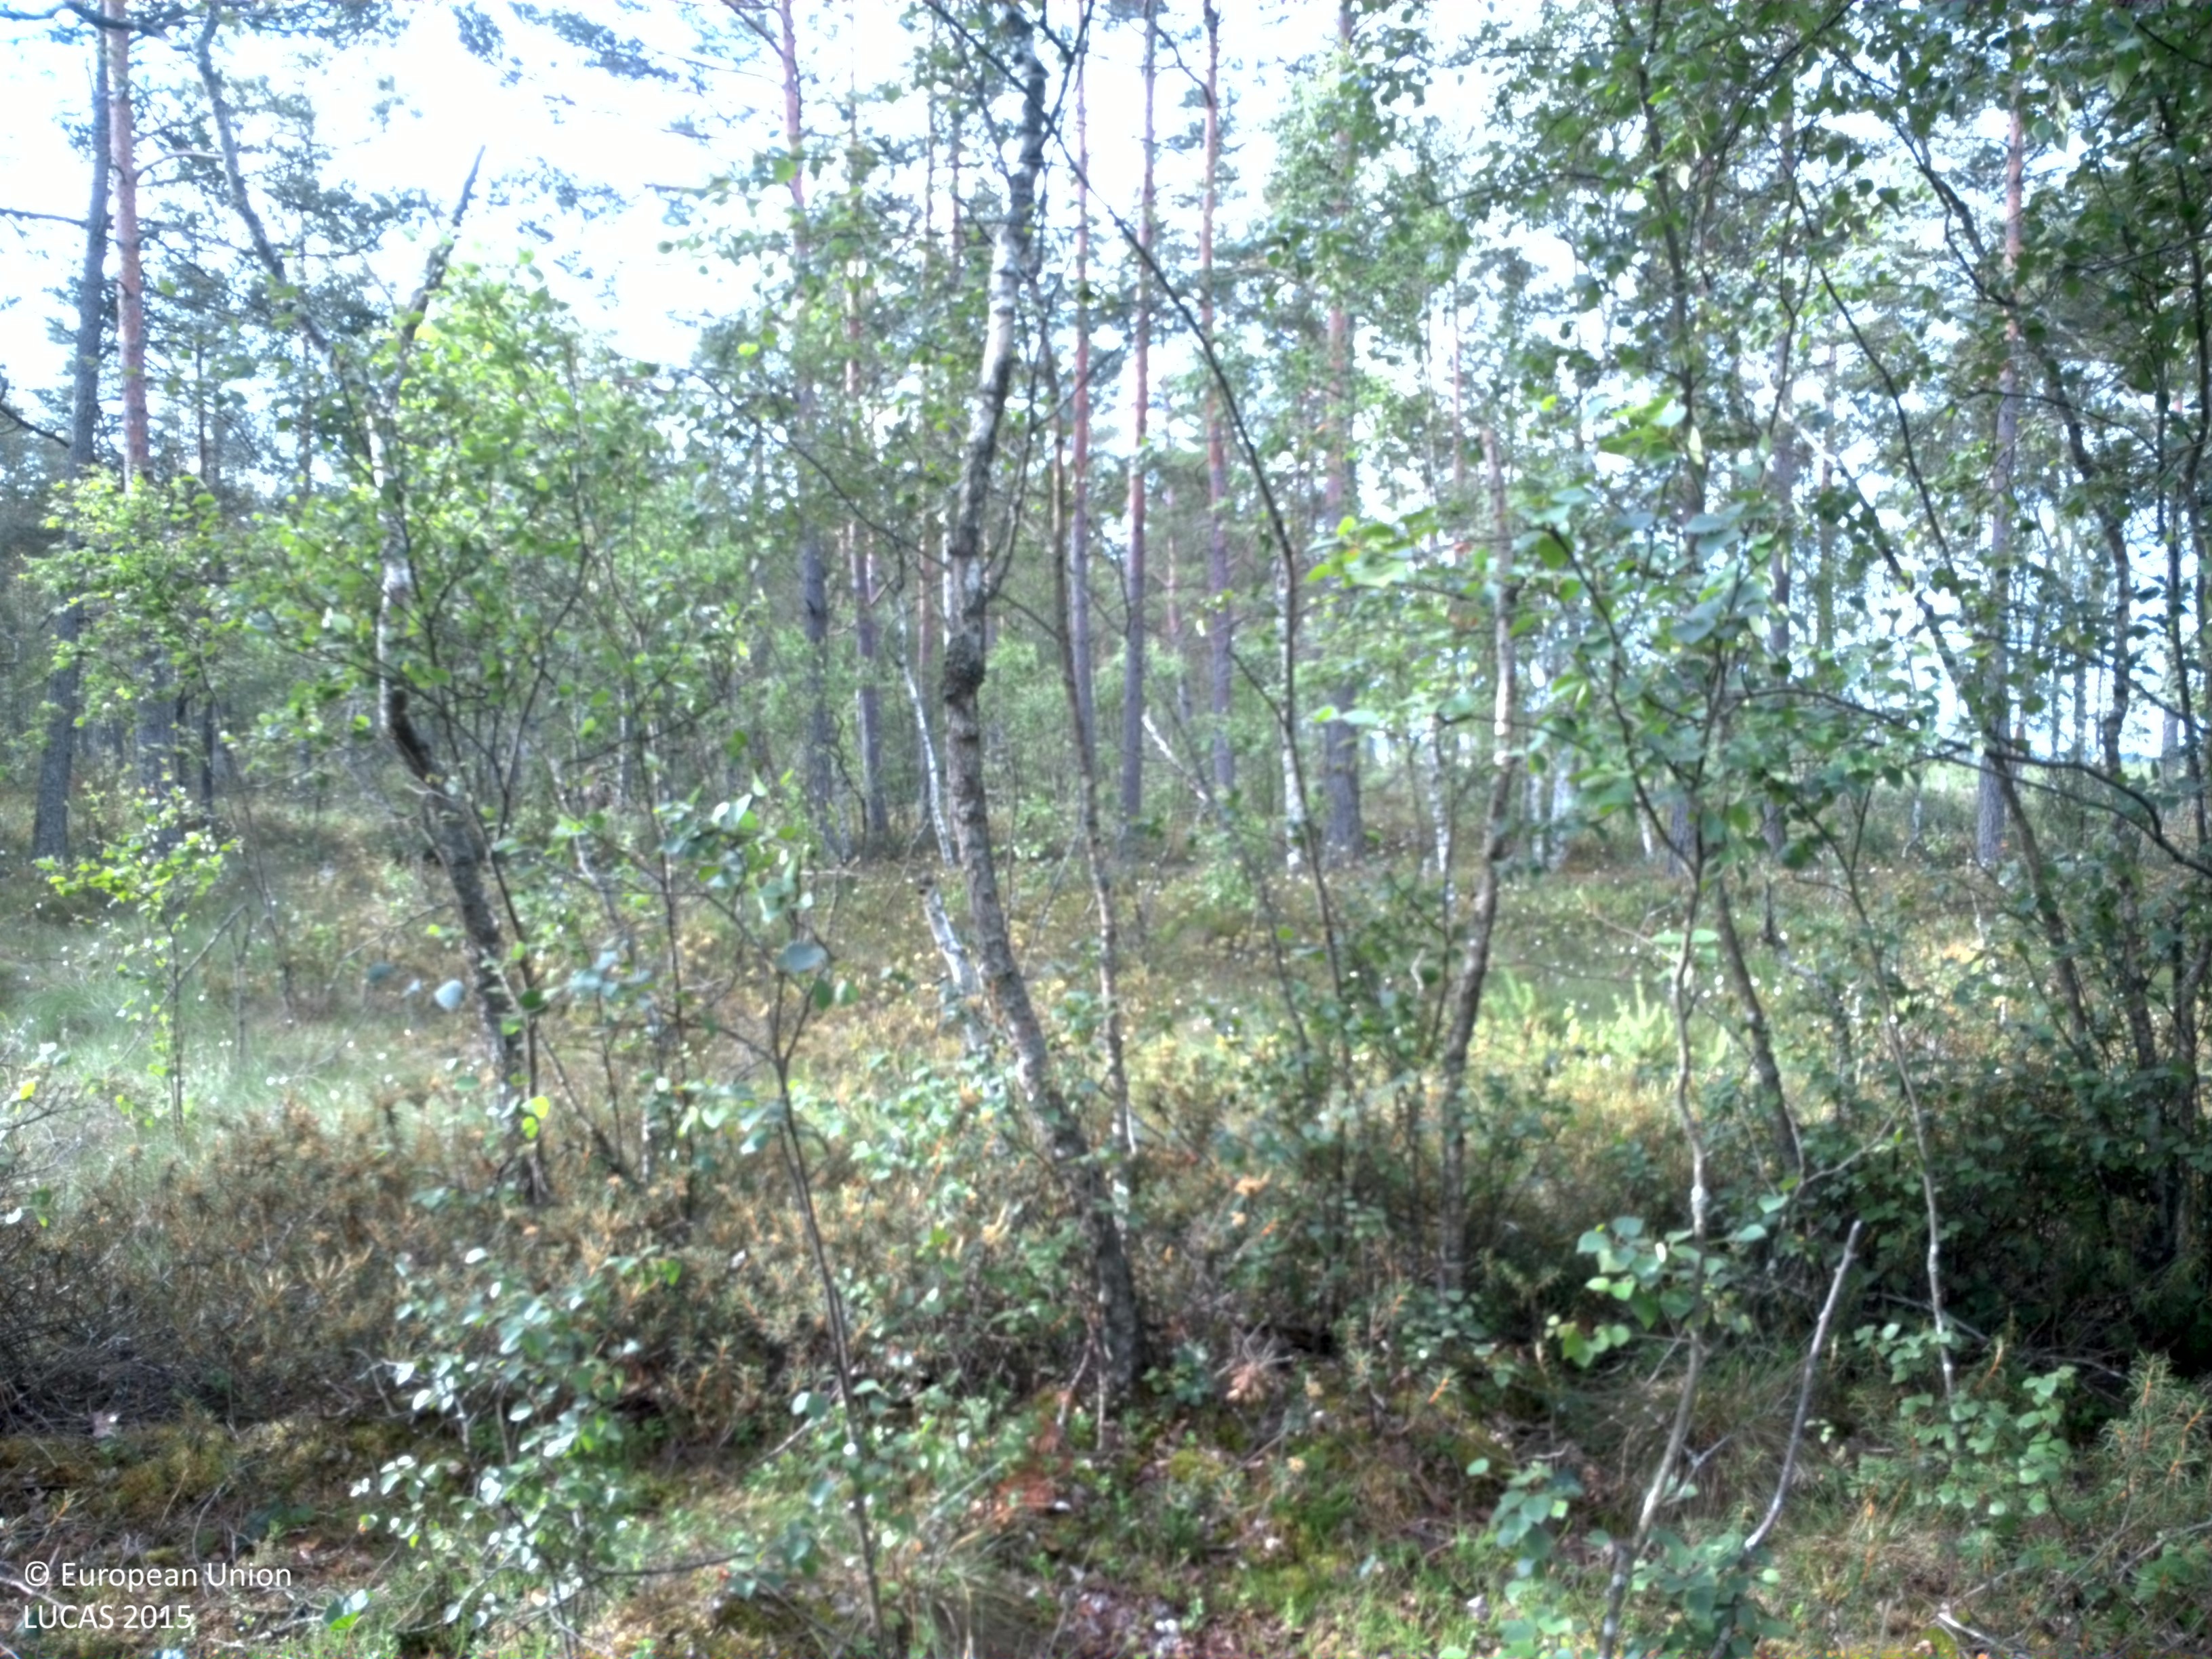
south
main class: Woodland
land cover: Pine dominated mixed woodland
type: boreal forest
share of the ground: 50 - 75 %
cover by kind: coniferous forest trees 35 %, broadleaved forest trees 25 %, shrubs 25 %, lichens and mosses 15 %
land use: Forestry
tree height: > 5 m
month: July
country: SE
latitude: 58.3579
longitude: 14.0100
